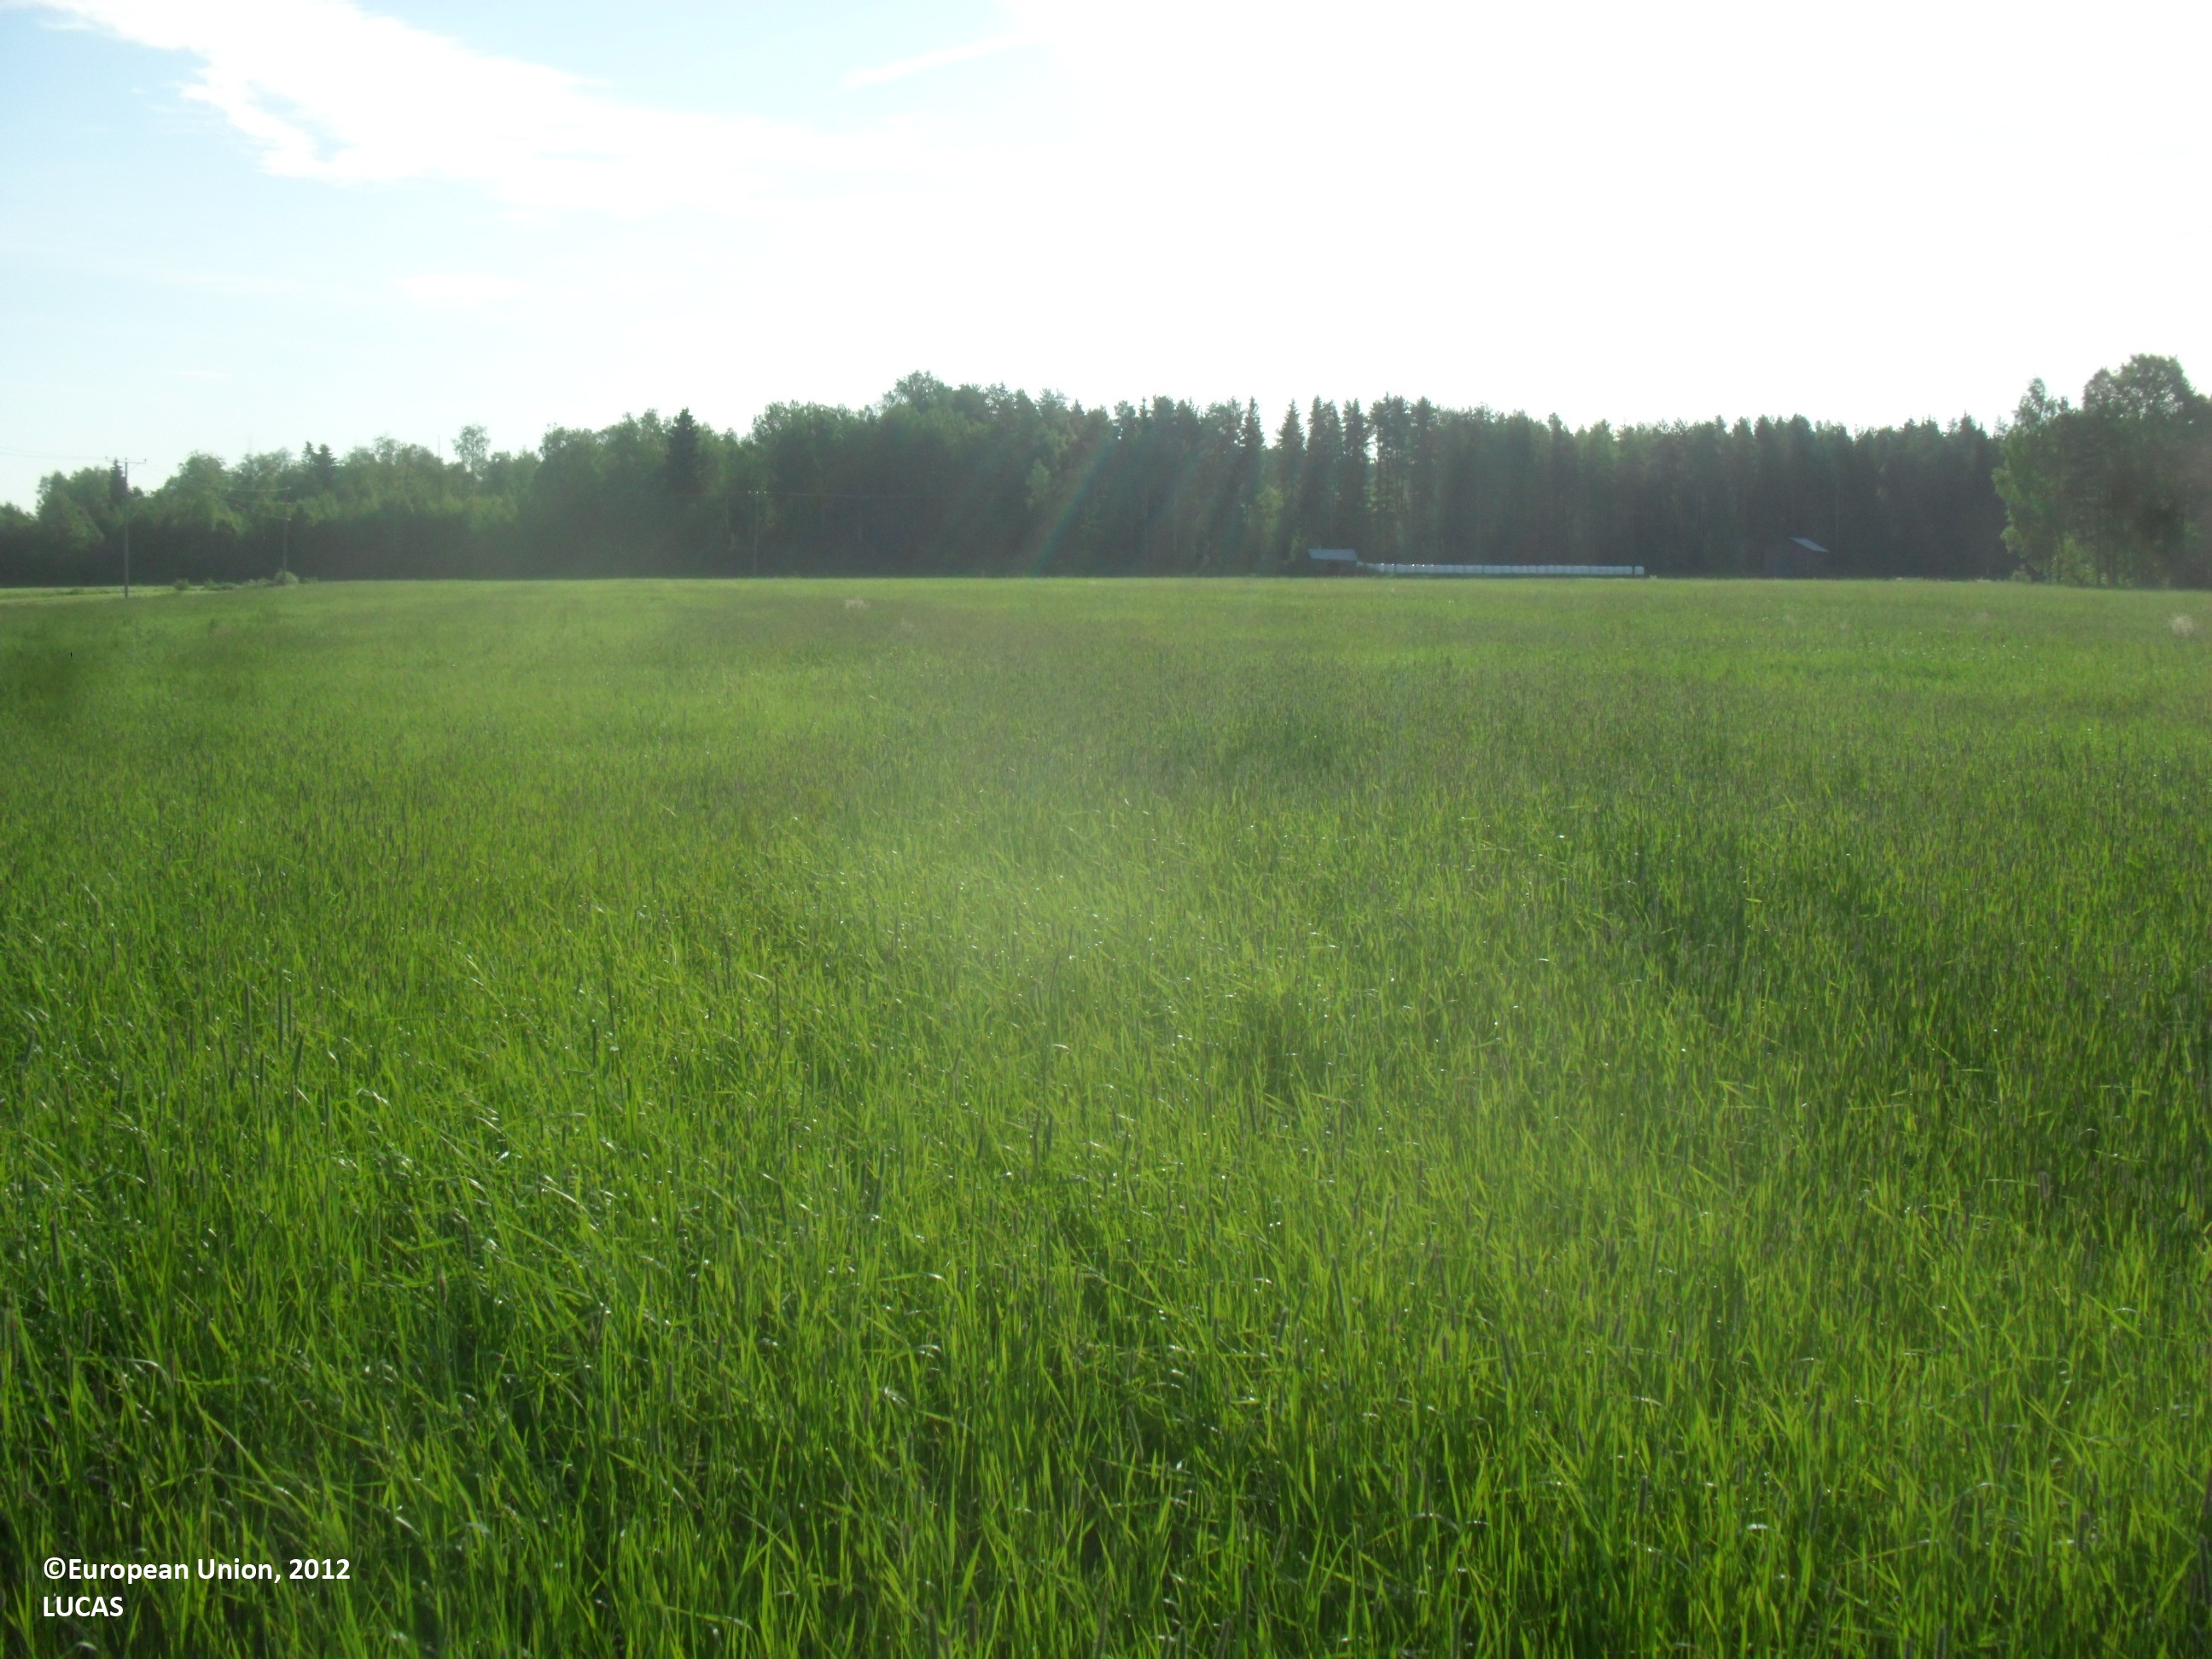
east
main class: Cropland
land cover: Temporary grasslands
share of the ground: > 75 %
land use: Agriculture (excluding fallow land and kitchen gardens)
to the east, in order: Temporary grasslands; Spontaneously vegetated surfaces; Ditches and canals; Spontaneously vegetated surfaces; Temporary grasslands
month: July
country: FI
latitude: 63.5585
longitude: 23.7329
